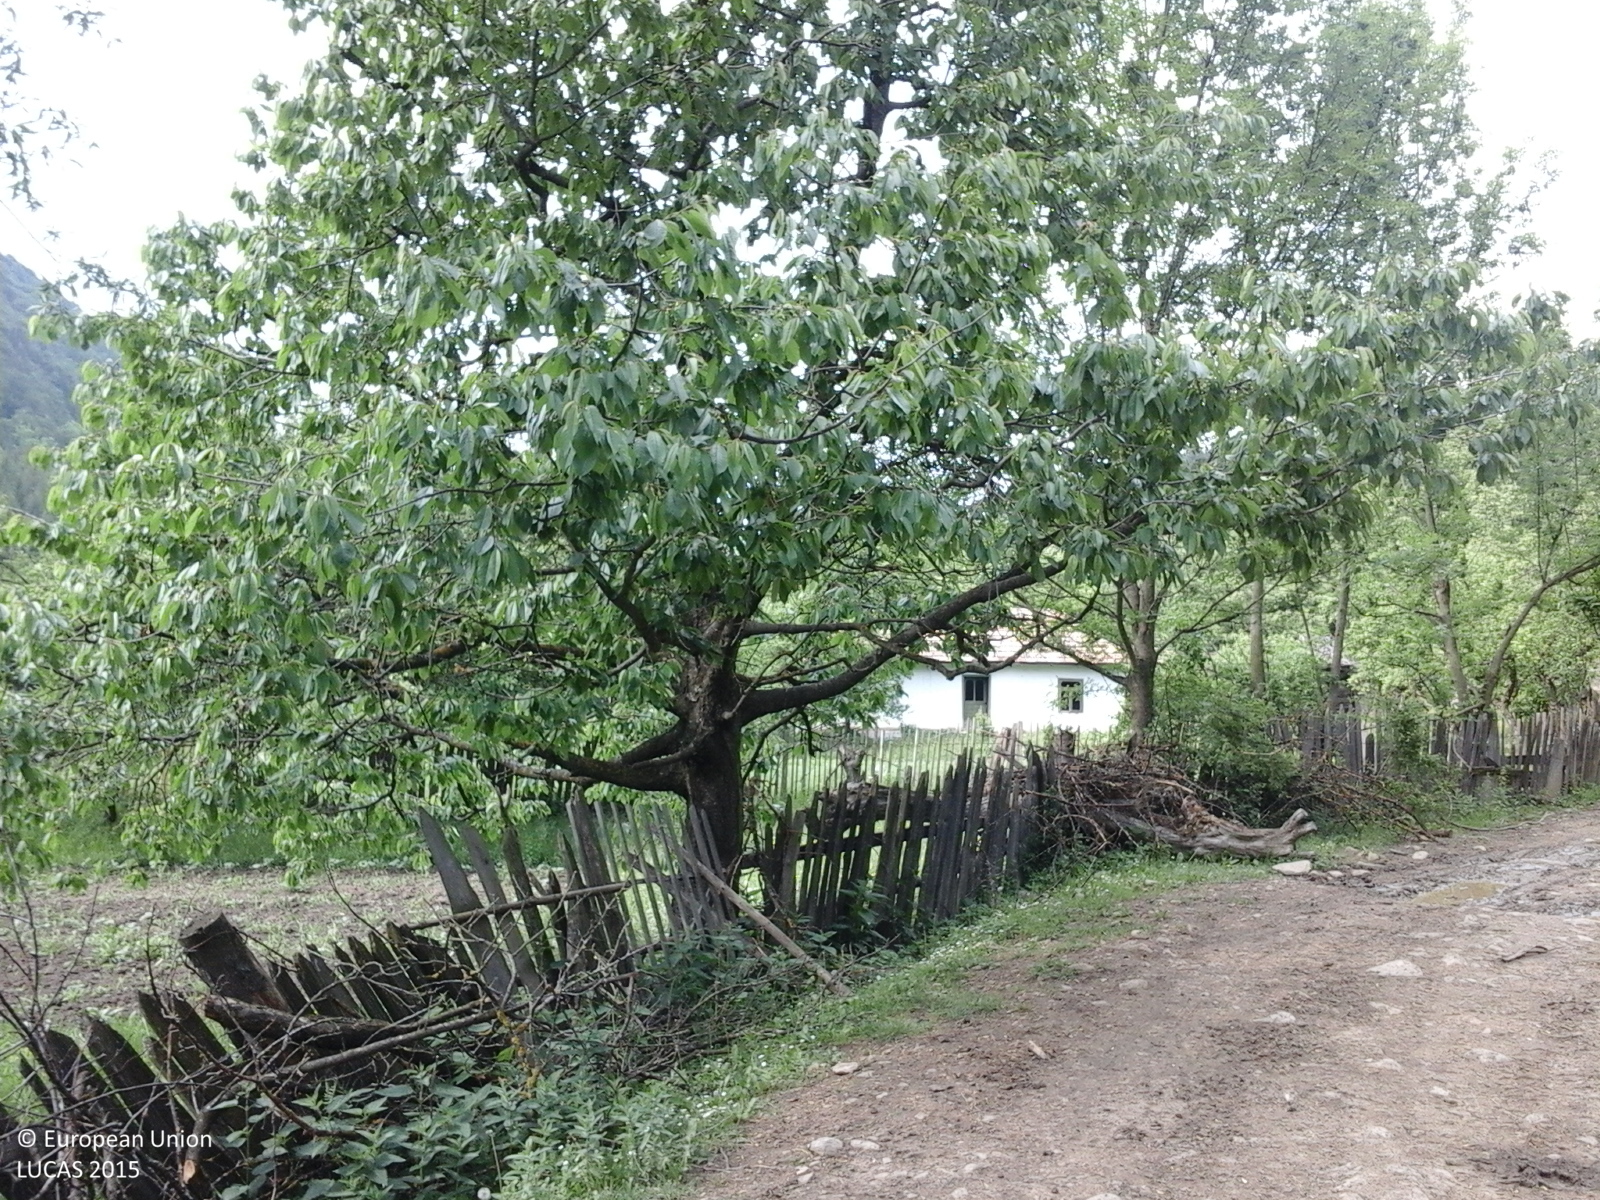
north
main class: Woodland
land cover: Spruce dominated coniferous woodland
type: alpine coniferous forest
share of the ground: > 75 %
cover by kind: coniferous forest trees 90 %, broadleaved forest trees 10 %
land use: Forestry
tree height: > 5 m
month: June
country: RO
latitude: 46.5370
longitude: 26.2038
